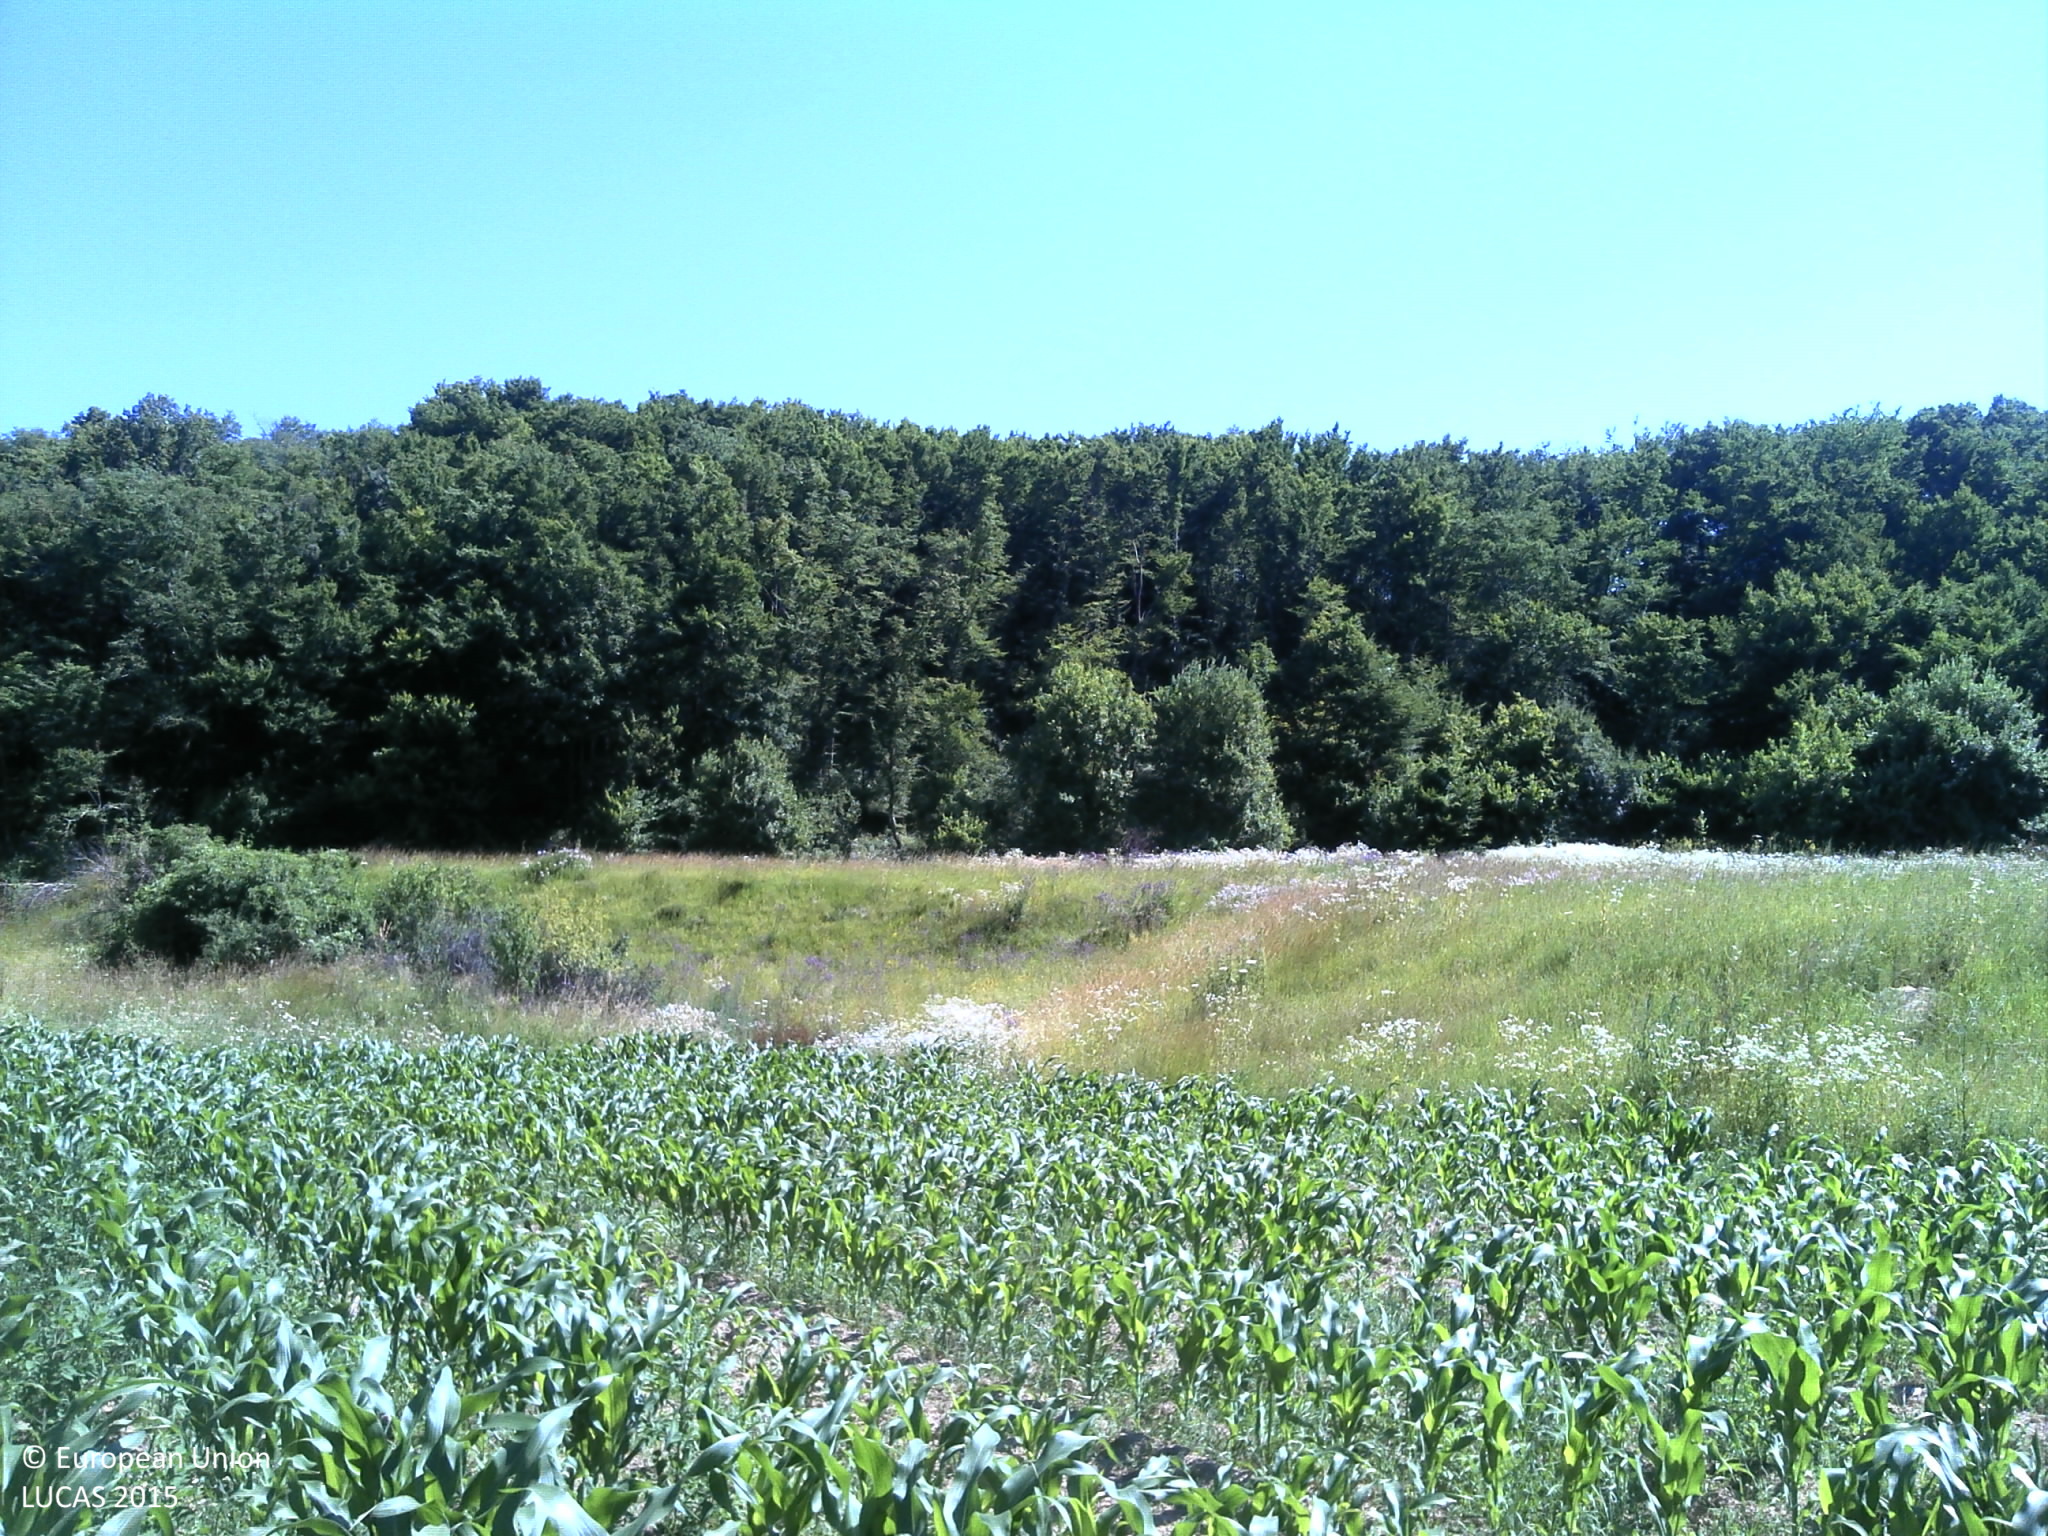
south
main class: Cropland
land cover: Maize
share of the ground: > 75 %
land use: Agriculture (excluding fallow land and kitchen gardens)
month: July
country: HR
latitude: 44.9452
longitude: 15.1526
